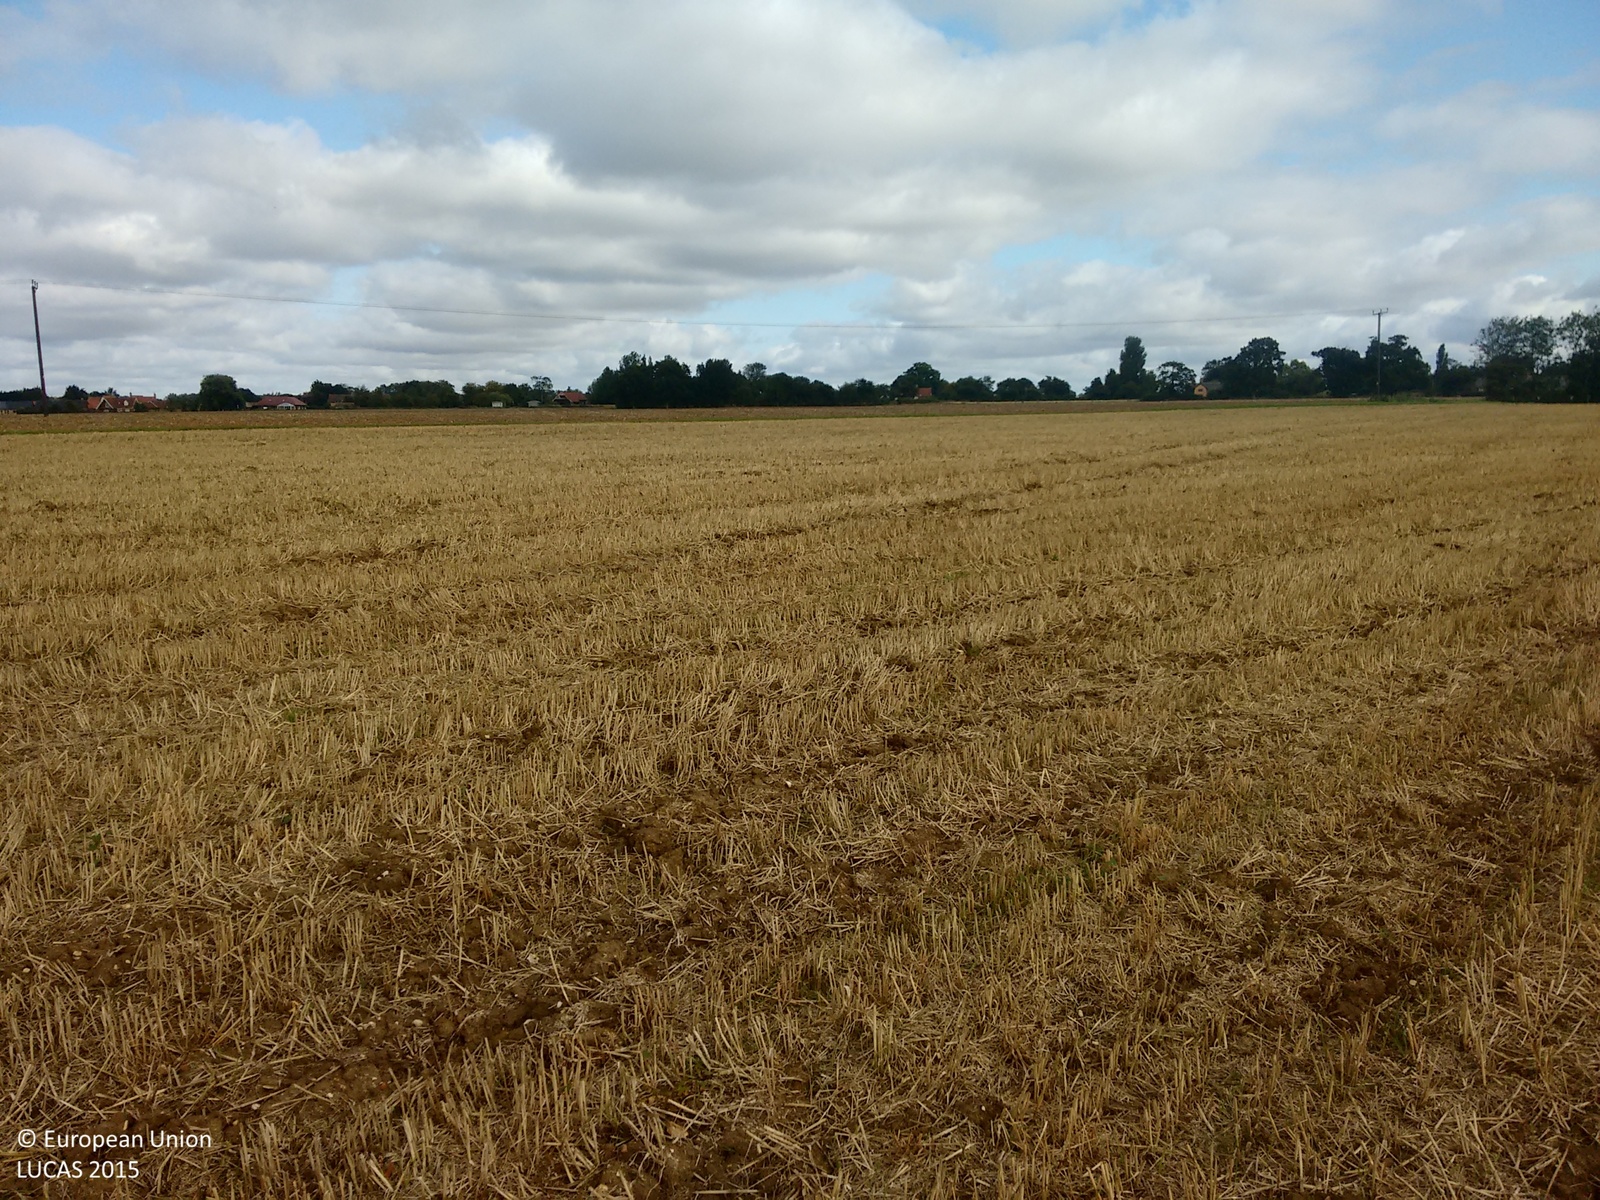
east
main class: Cropland
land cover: Common wheat
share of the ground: 25 - 50 %
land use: Agriculture (excluding fallow land and kitchen gardens)
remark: Harvested field
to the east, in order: Common wheat; Grass margins; Tracks; Grass margins; Rape and turnip rape; Electric lines; Rape and turnip rape
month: September
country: GB
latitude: 52.2453
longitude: 0.9101
